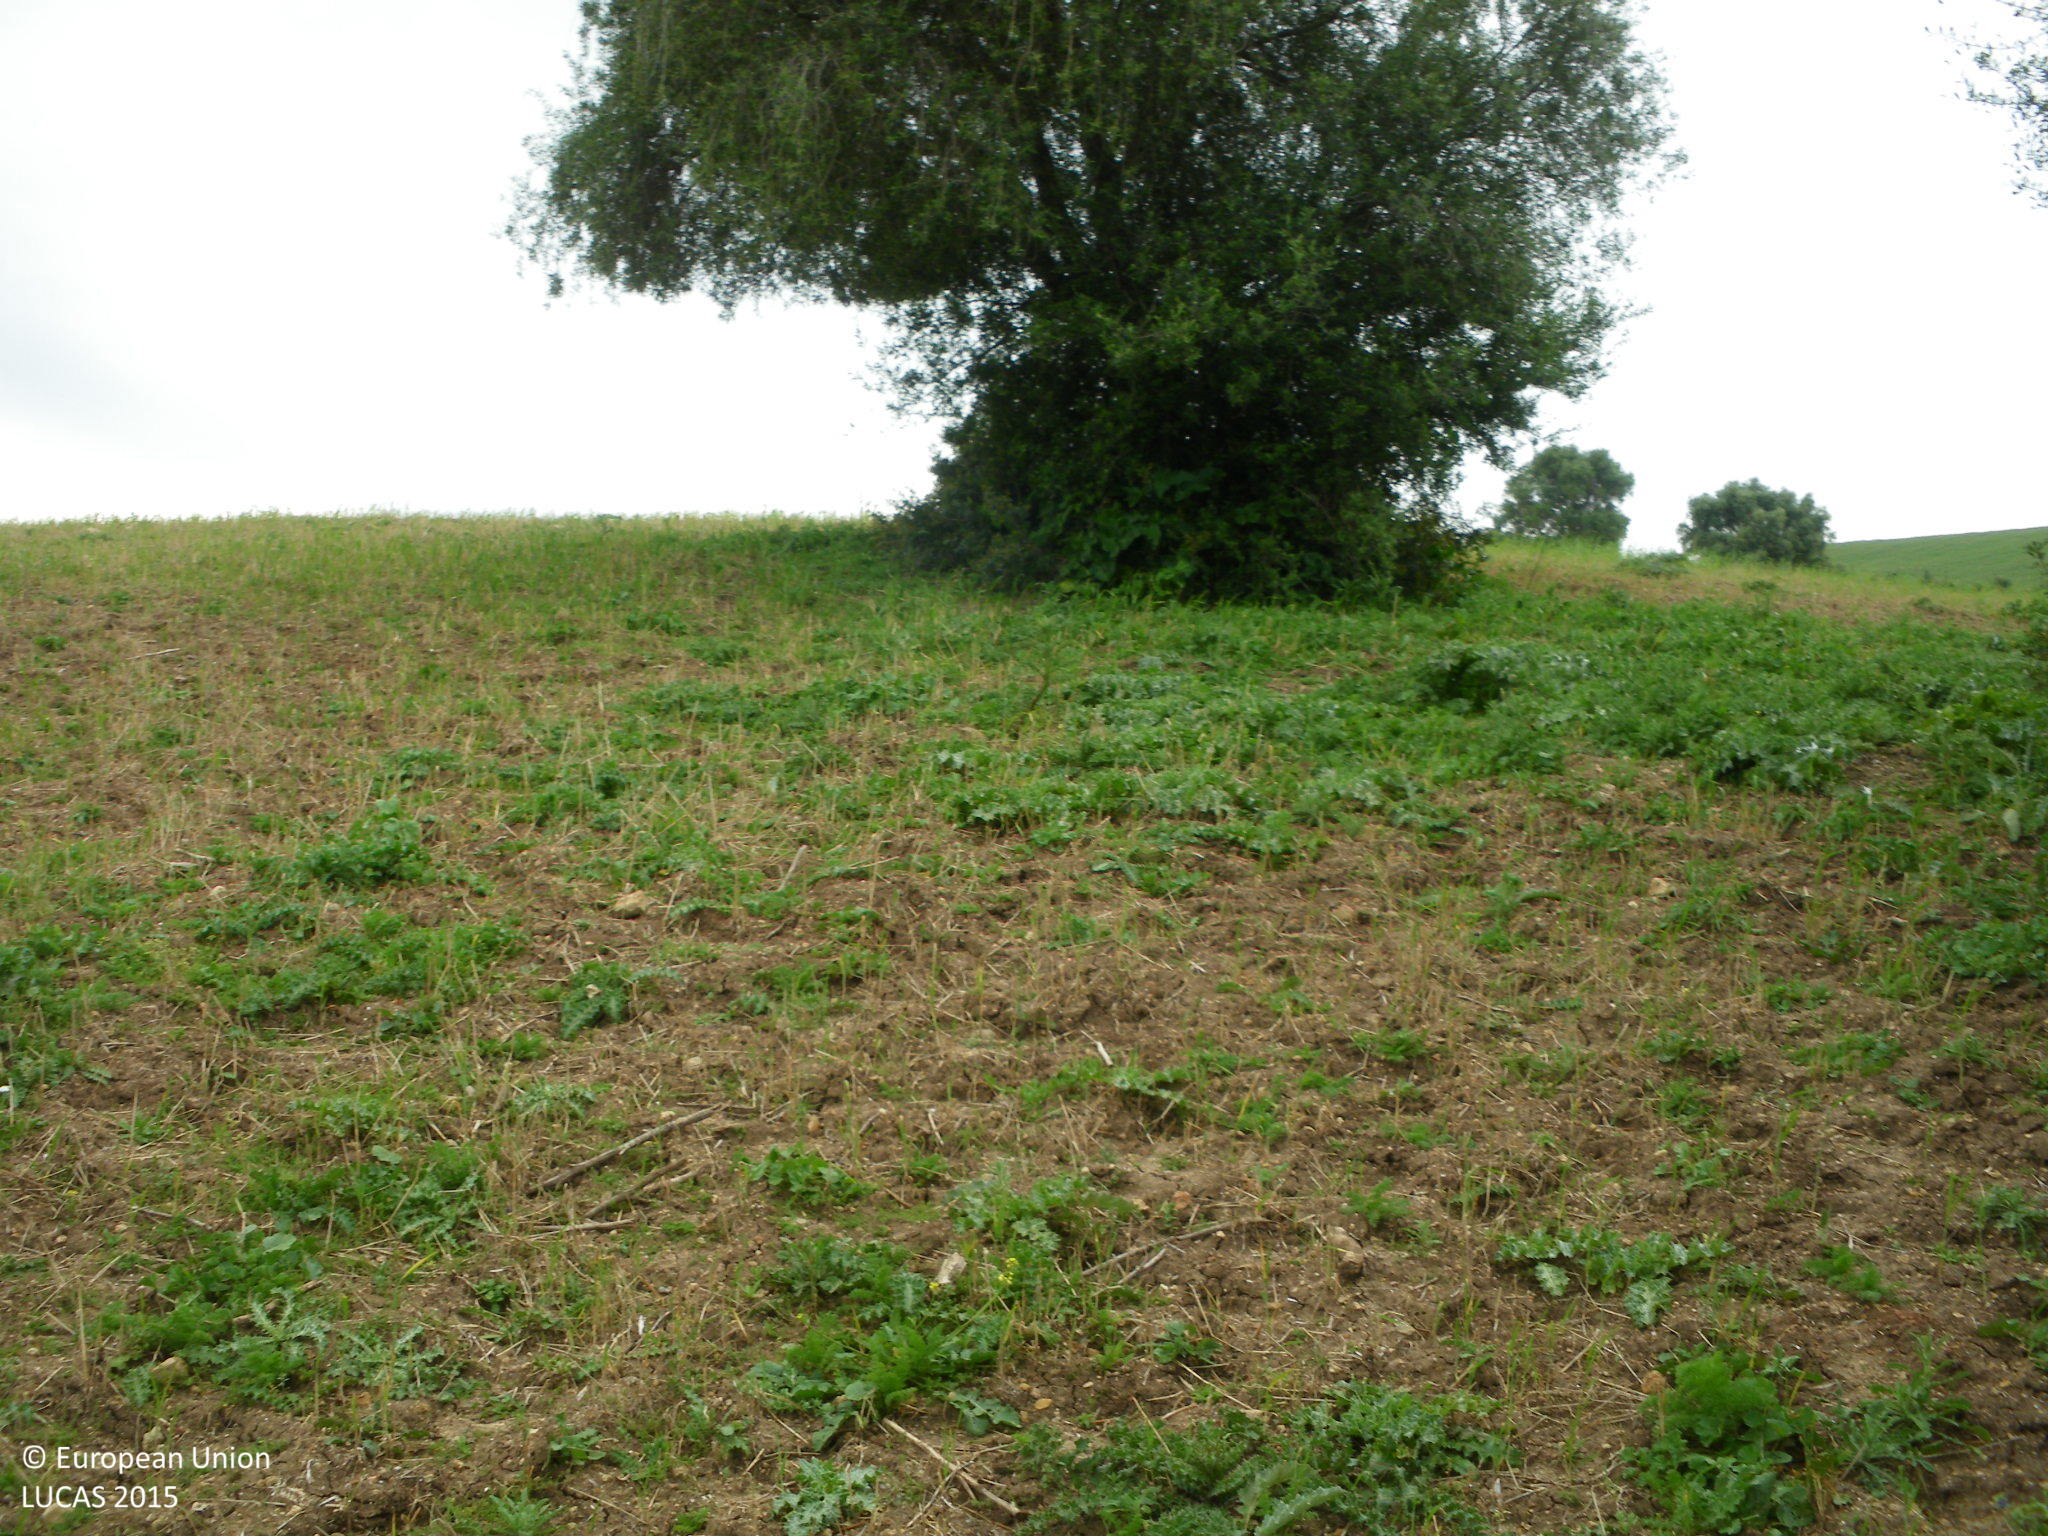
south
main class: Woodland
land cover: Broadleaved woodland
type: broadleaved evergreen forest
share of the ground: 10 - 25 %
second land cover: Spontaneously vegetated surfaces
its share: 50 - 75 %
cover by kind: herbaceous plants 85 %, broadleaved forest trees 15 %
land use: Forestry
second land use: Agriculture (excluding fallow land and kitchen gardens)
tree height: > 5 m
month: April
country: ES
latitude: 36.5896
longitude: -5.9801
